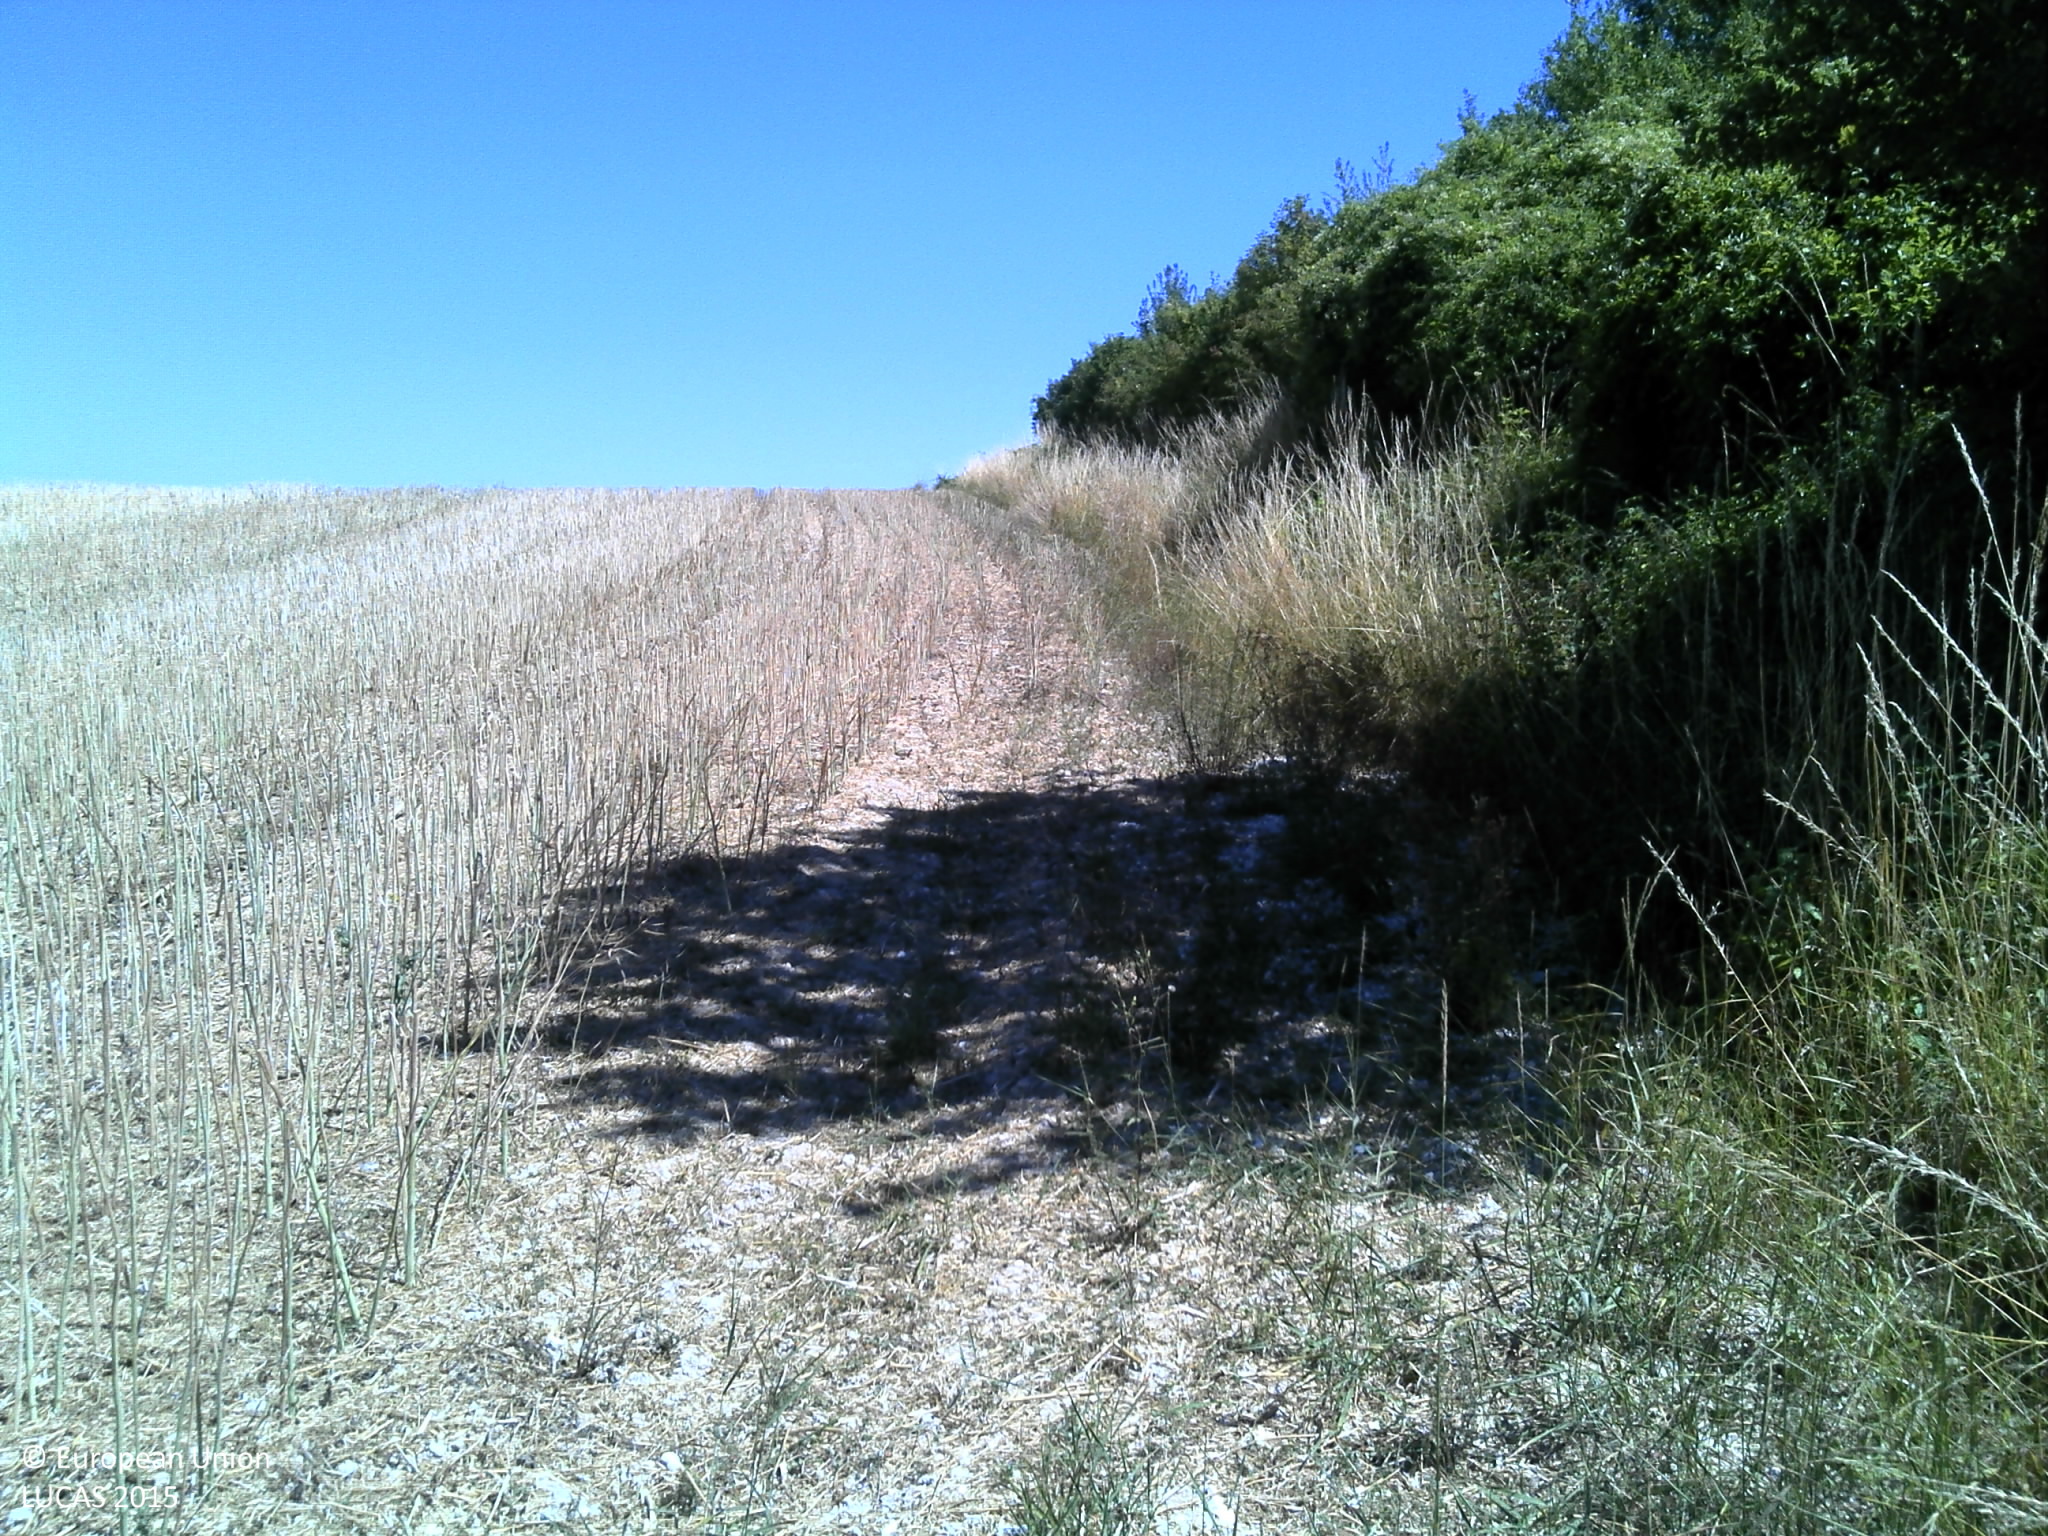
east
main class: Cropland
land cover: Rape and turnip rape
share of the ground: > 75 %
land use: Agriculture (excluding fallow land and kitchen gardens)
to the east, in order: Rape and turnip rape; Broadleaved woodland; Rape and turnip rape; Grass margins; Tracks; Spontaneously vegetated surfaces; Sugar beet
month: August
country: FR
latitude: 49.2490
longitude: 4.6805
